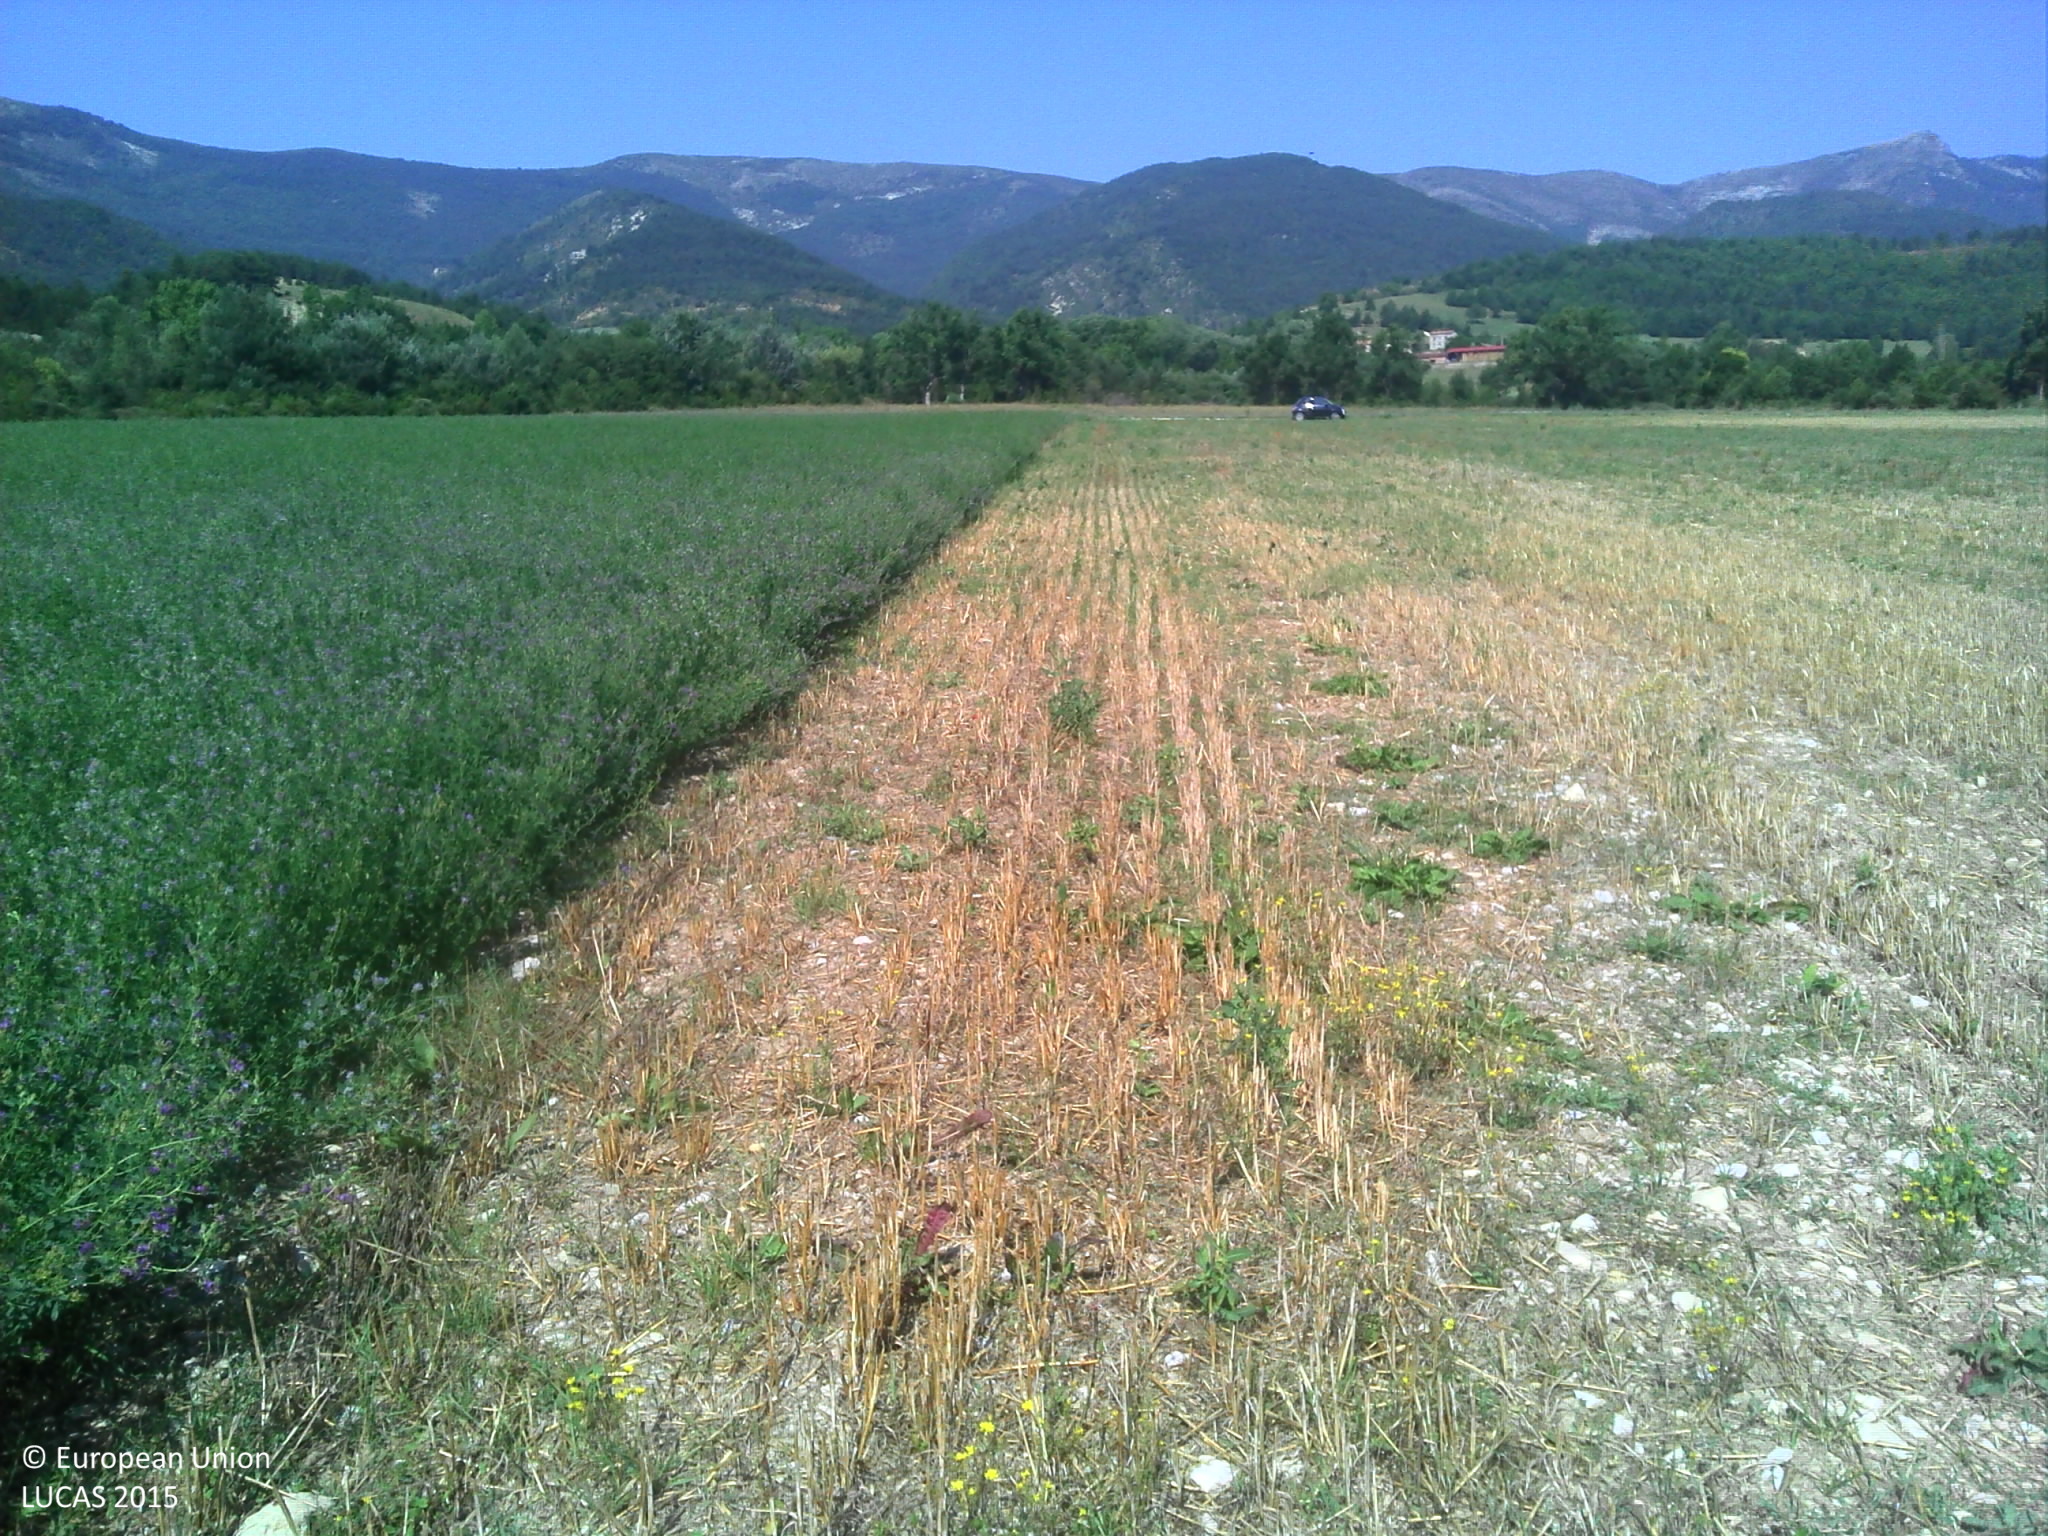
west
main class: Grassland
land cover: Spontaneously vegetated surfaces
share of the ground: > 75 %
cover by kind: herbaceous plants 100 %
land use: Agriculture (excluding fallow land and kitchen gardens)
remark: Harvested field
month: August
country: FR
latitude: 44.0165
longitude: 6.3775
